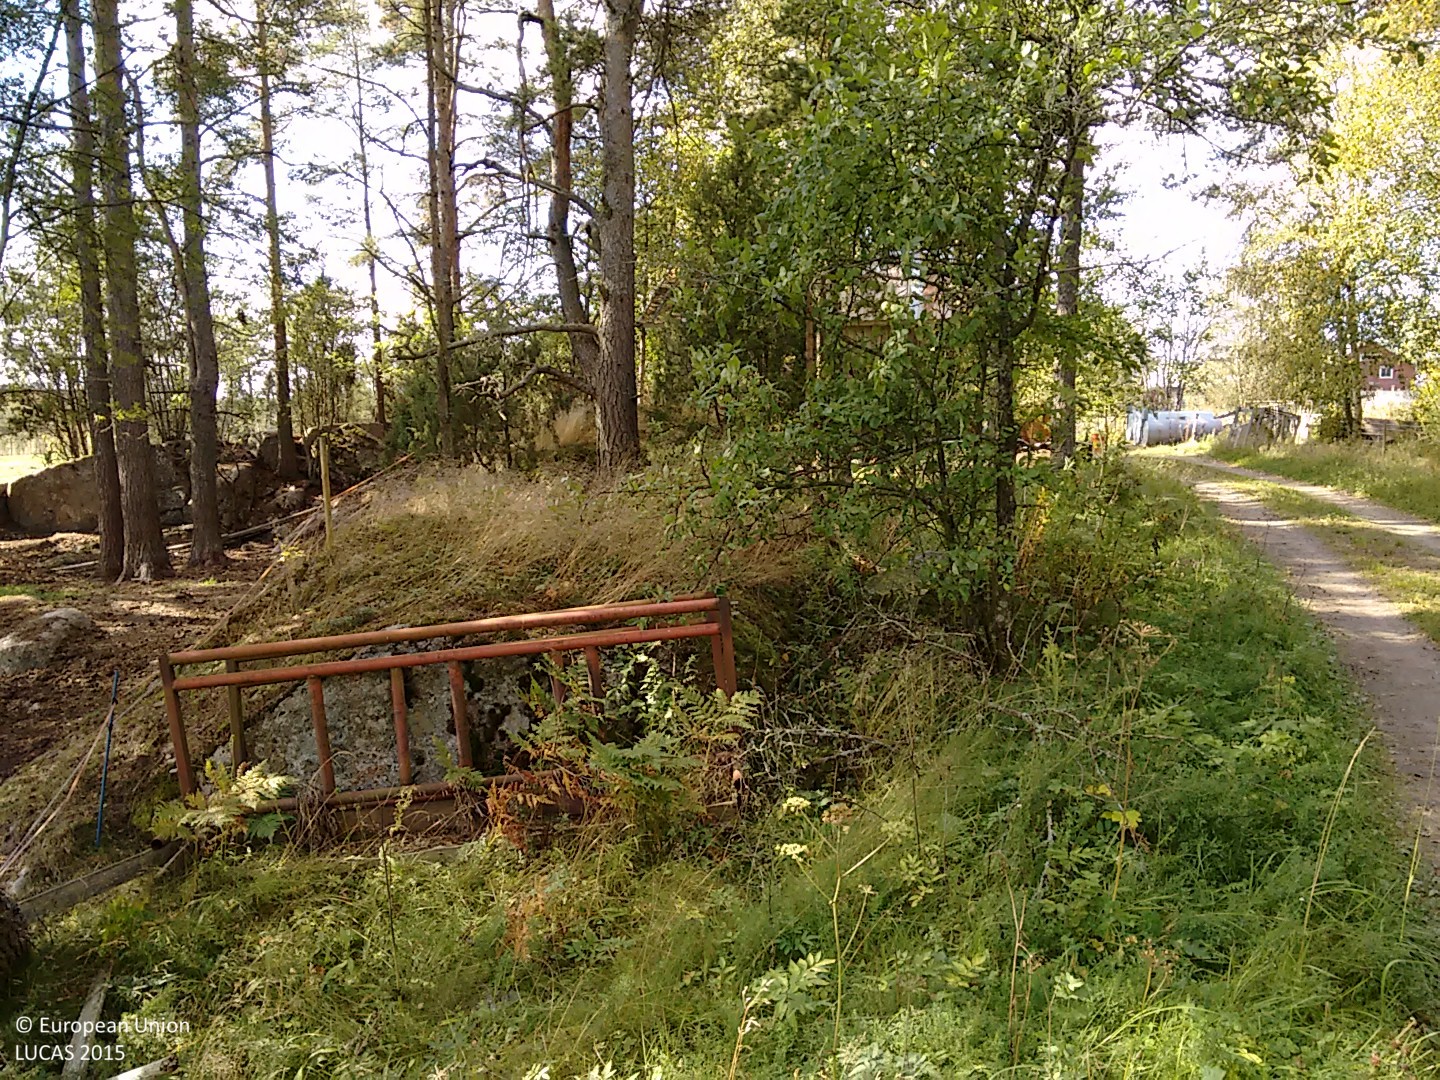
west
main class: Woodland
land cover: Pine dominated coniferous woodland
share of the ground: > 75 %
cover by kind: coniferous forest trees 80 %, unconsolidated bare surface 15 %, broadleaved forest trees 5 %
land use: Agriculture (excluding fallow land and kitchen gardens)
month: September
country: FI
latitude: 60.9702
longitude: 21.6759
